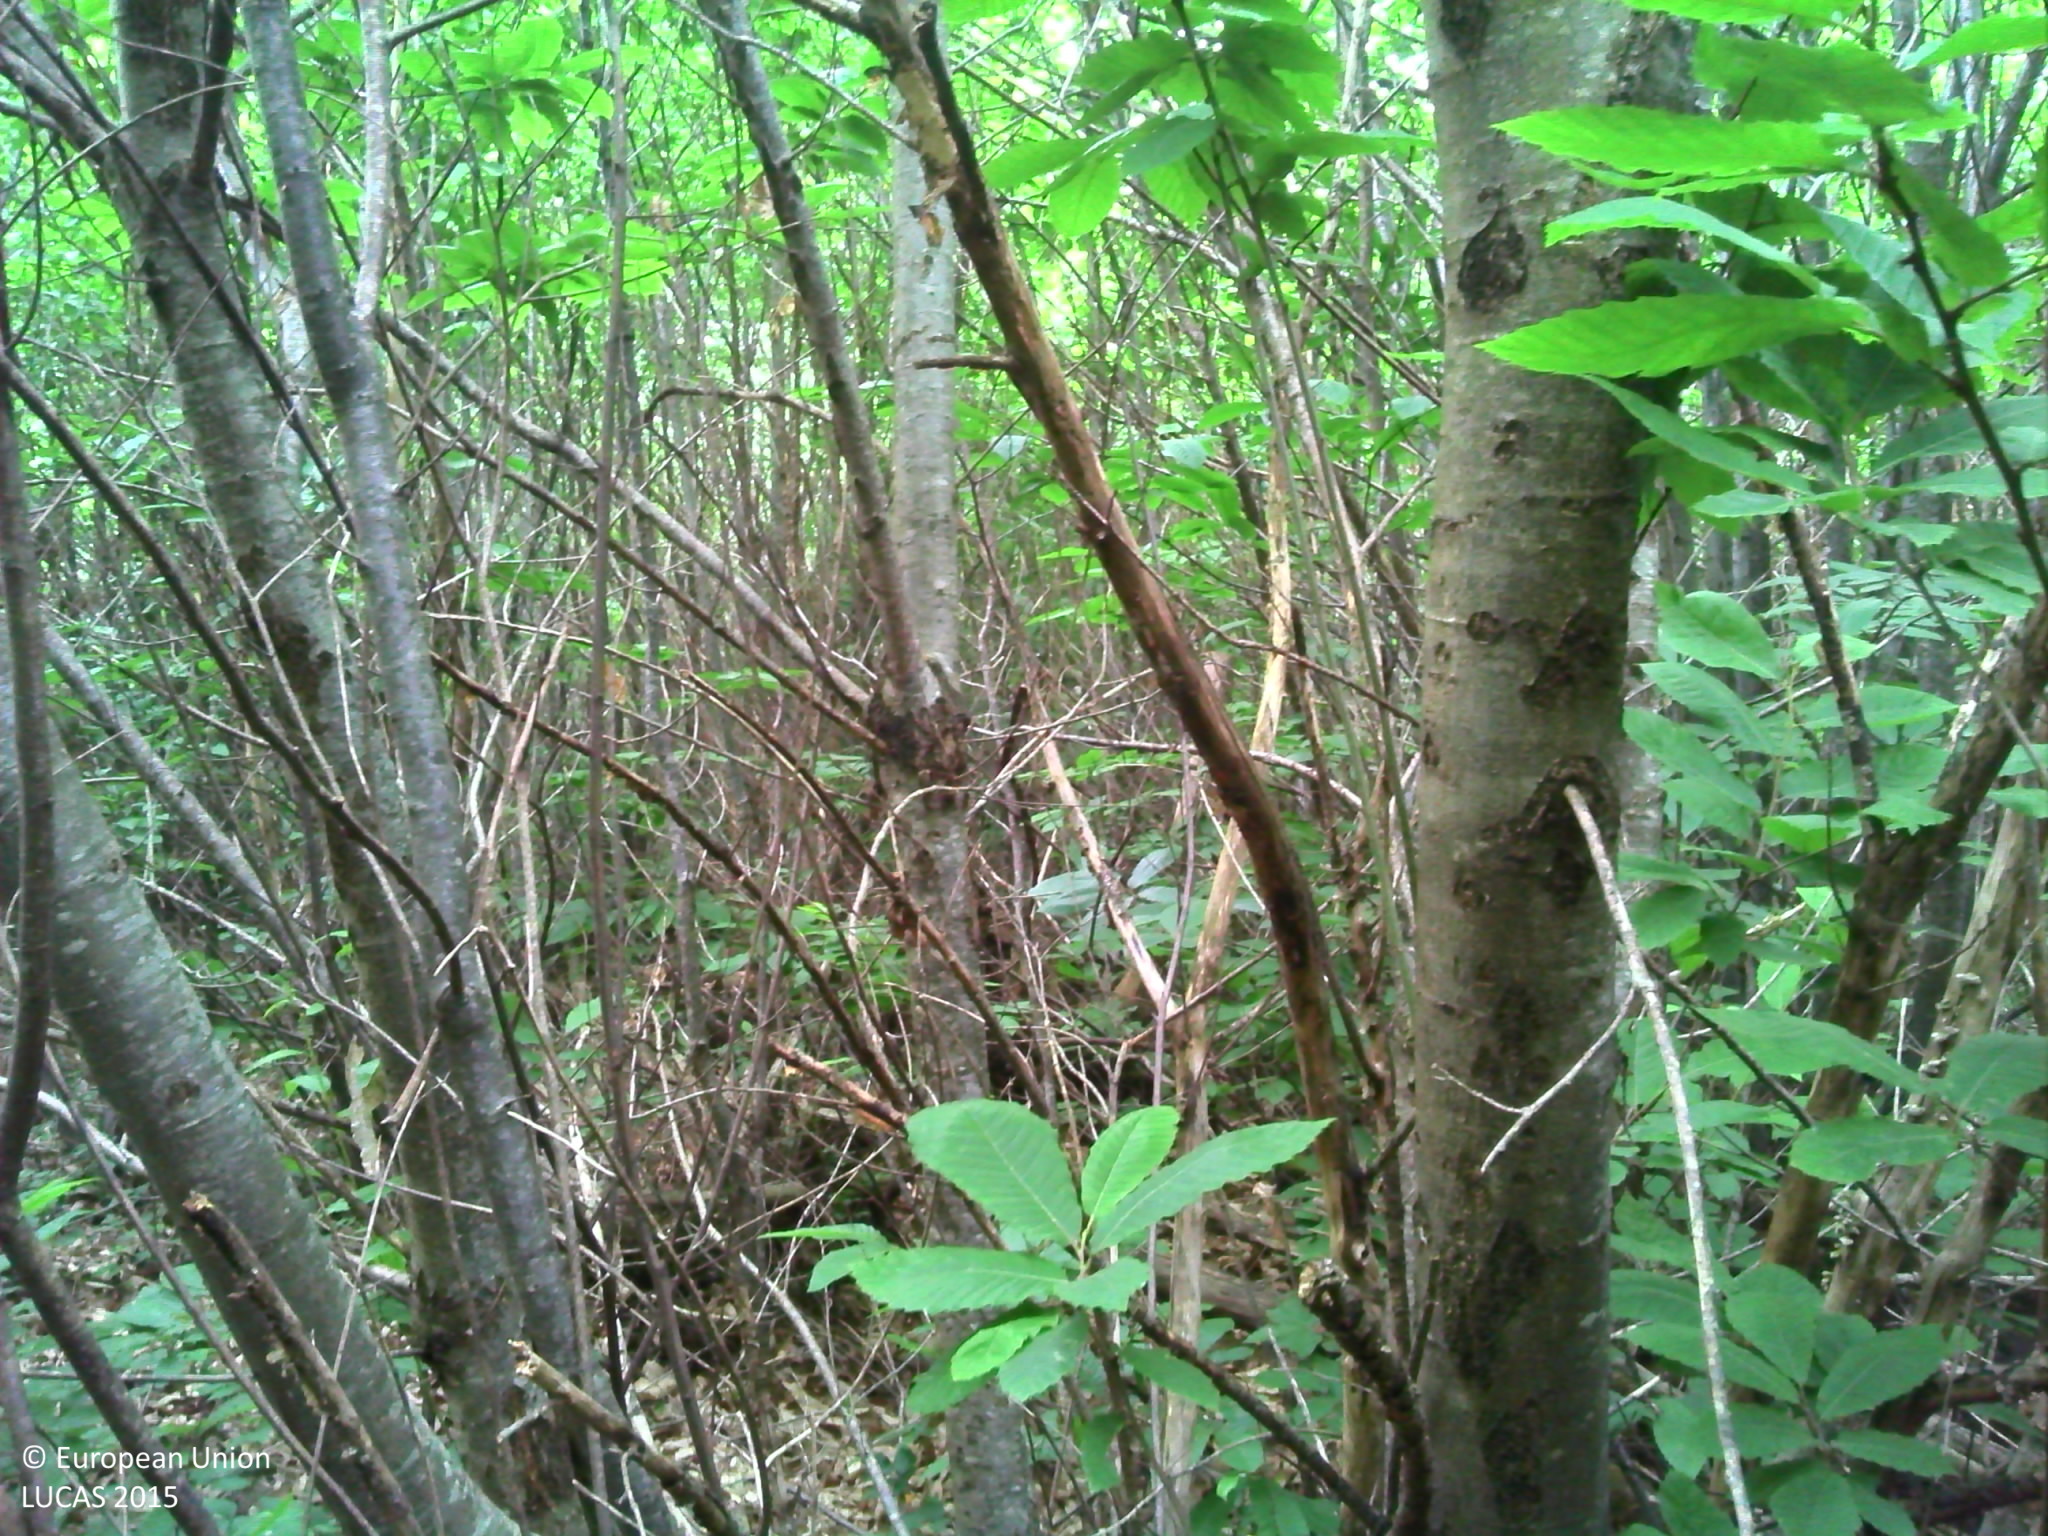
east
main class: Woodland
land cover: Broadleaved woodland
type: thermophilous deciduous forest
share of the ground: > 75 %
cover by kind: broadleaved forest trees 100 %
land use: Forestry
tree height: > 5 m
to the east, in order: Broadleaved woodland; Tracks; Broadleaved woodland
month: June
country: FR
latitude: 45.9298
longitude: 0.3244
